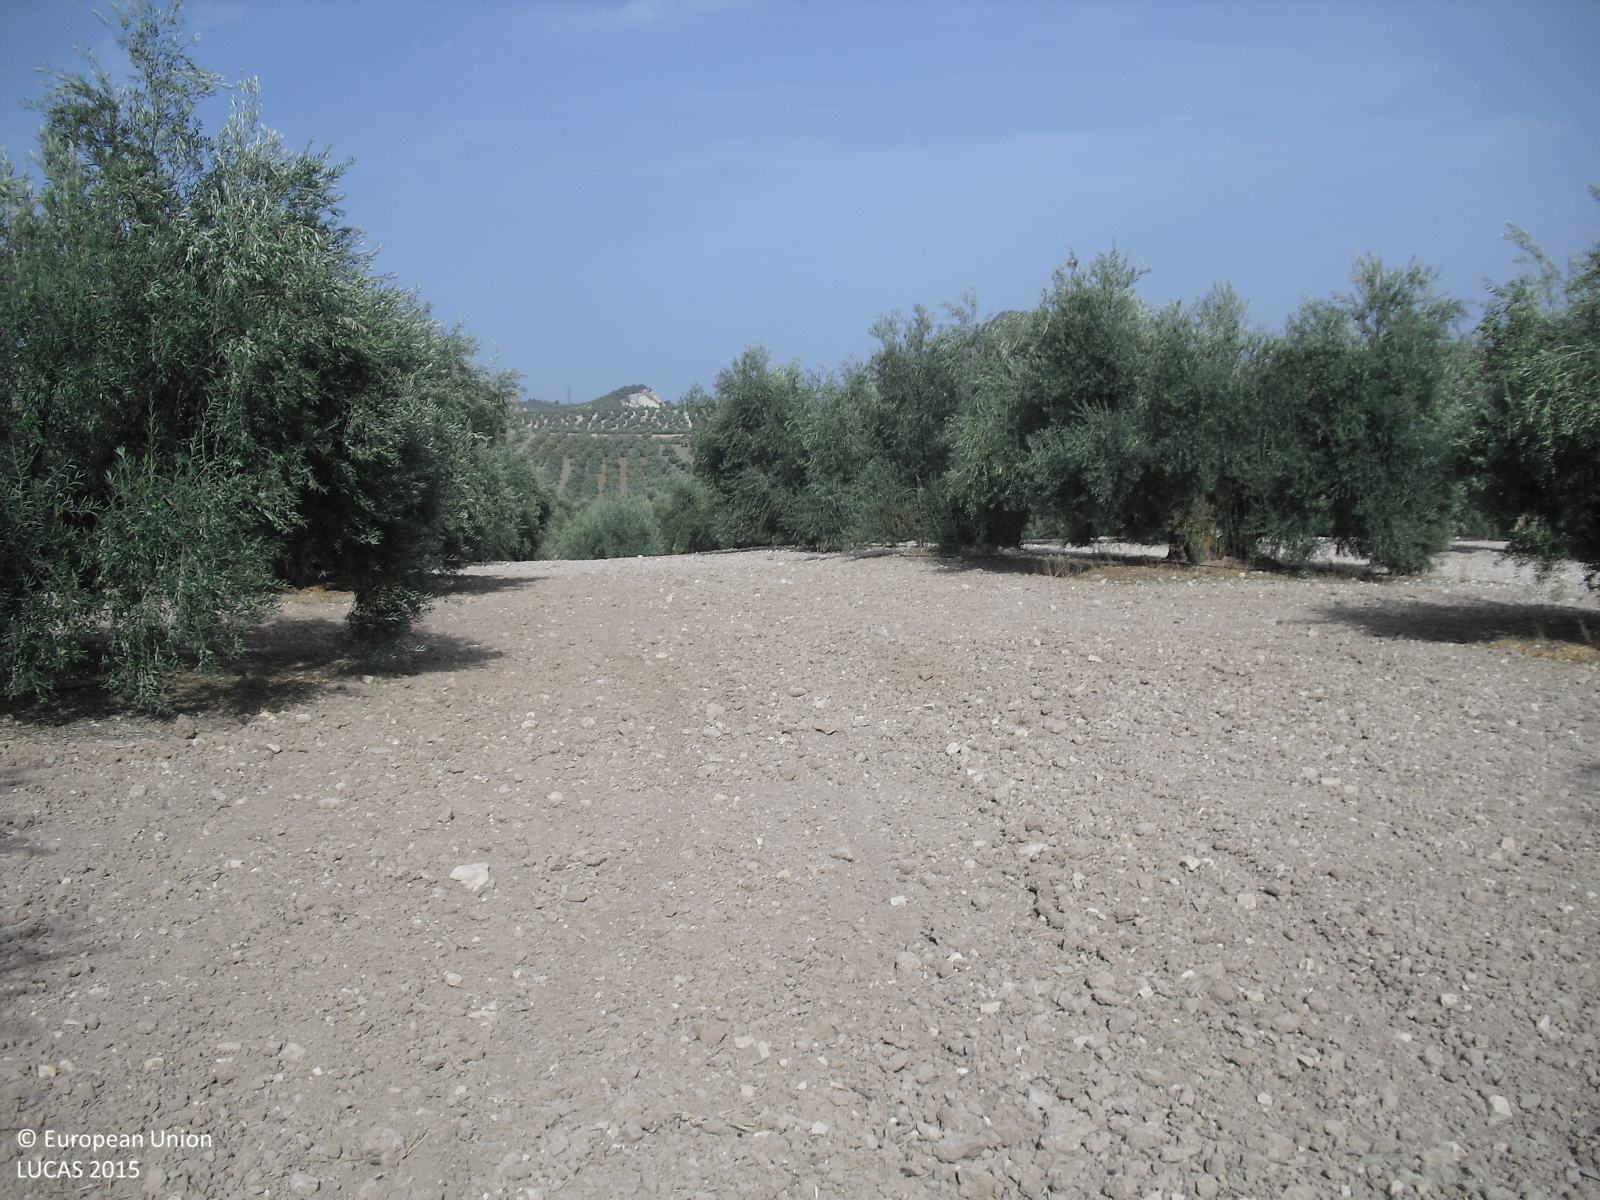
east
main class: Cropland
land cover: Olive groves
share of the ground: 25 - 50 %
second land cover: Other bare soil
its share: > 75 %
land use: Agriculture (excluding fallow land and kitchen gardens)
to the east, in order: Olive groves; Other bare soil; Tracks; Olive groves; Tracks; Olive groves
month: August
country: ES
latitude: 37.2849
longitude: -4.4259
